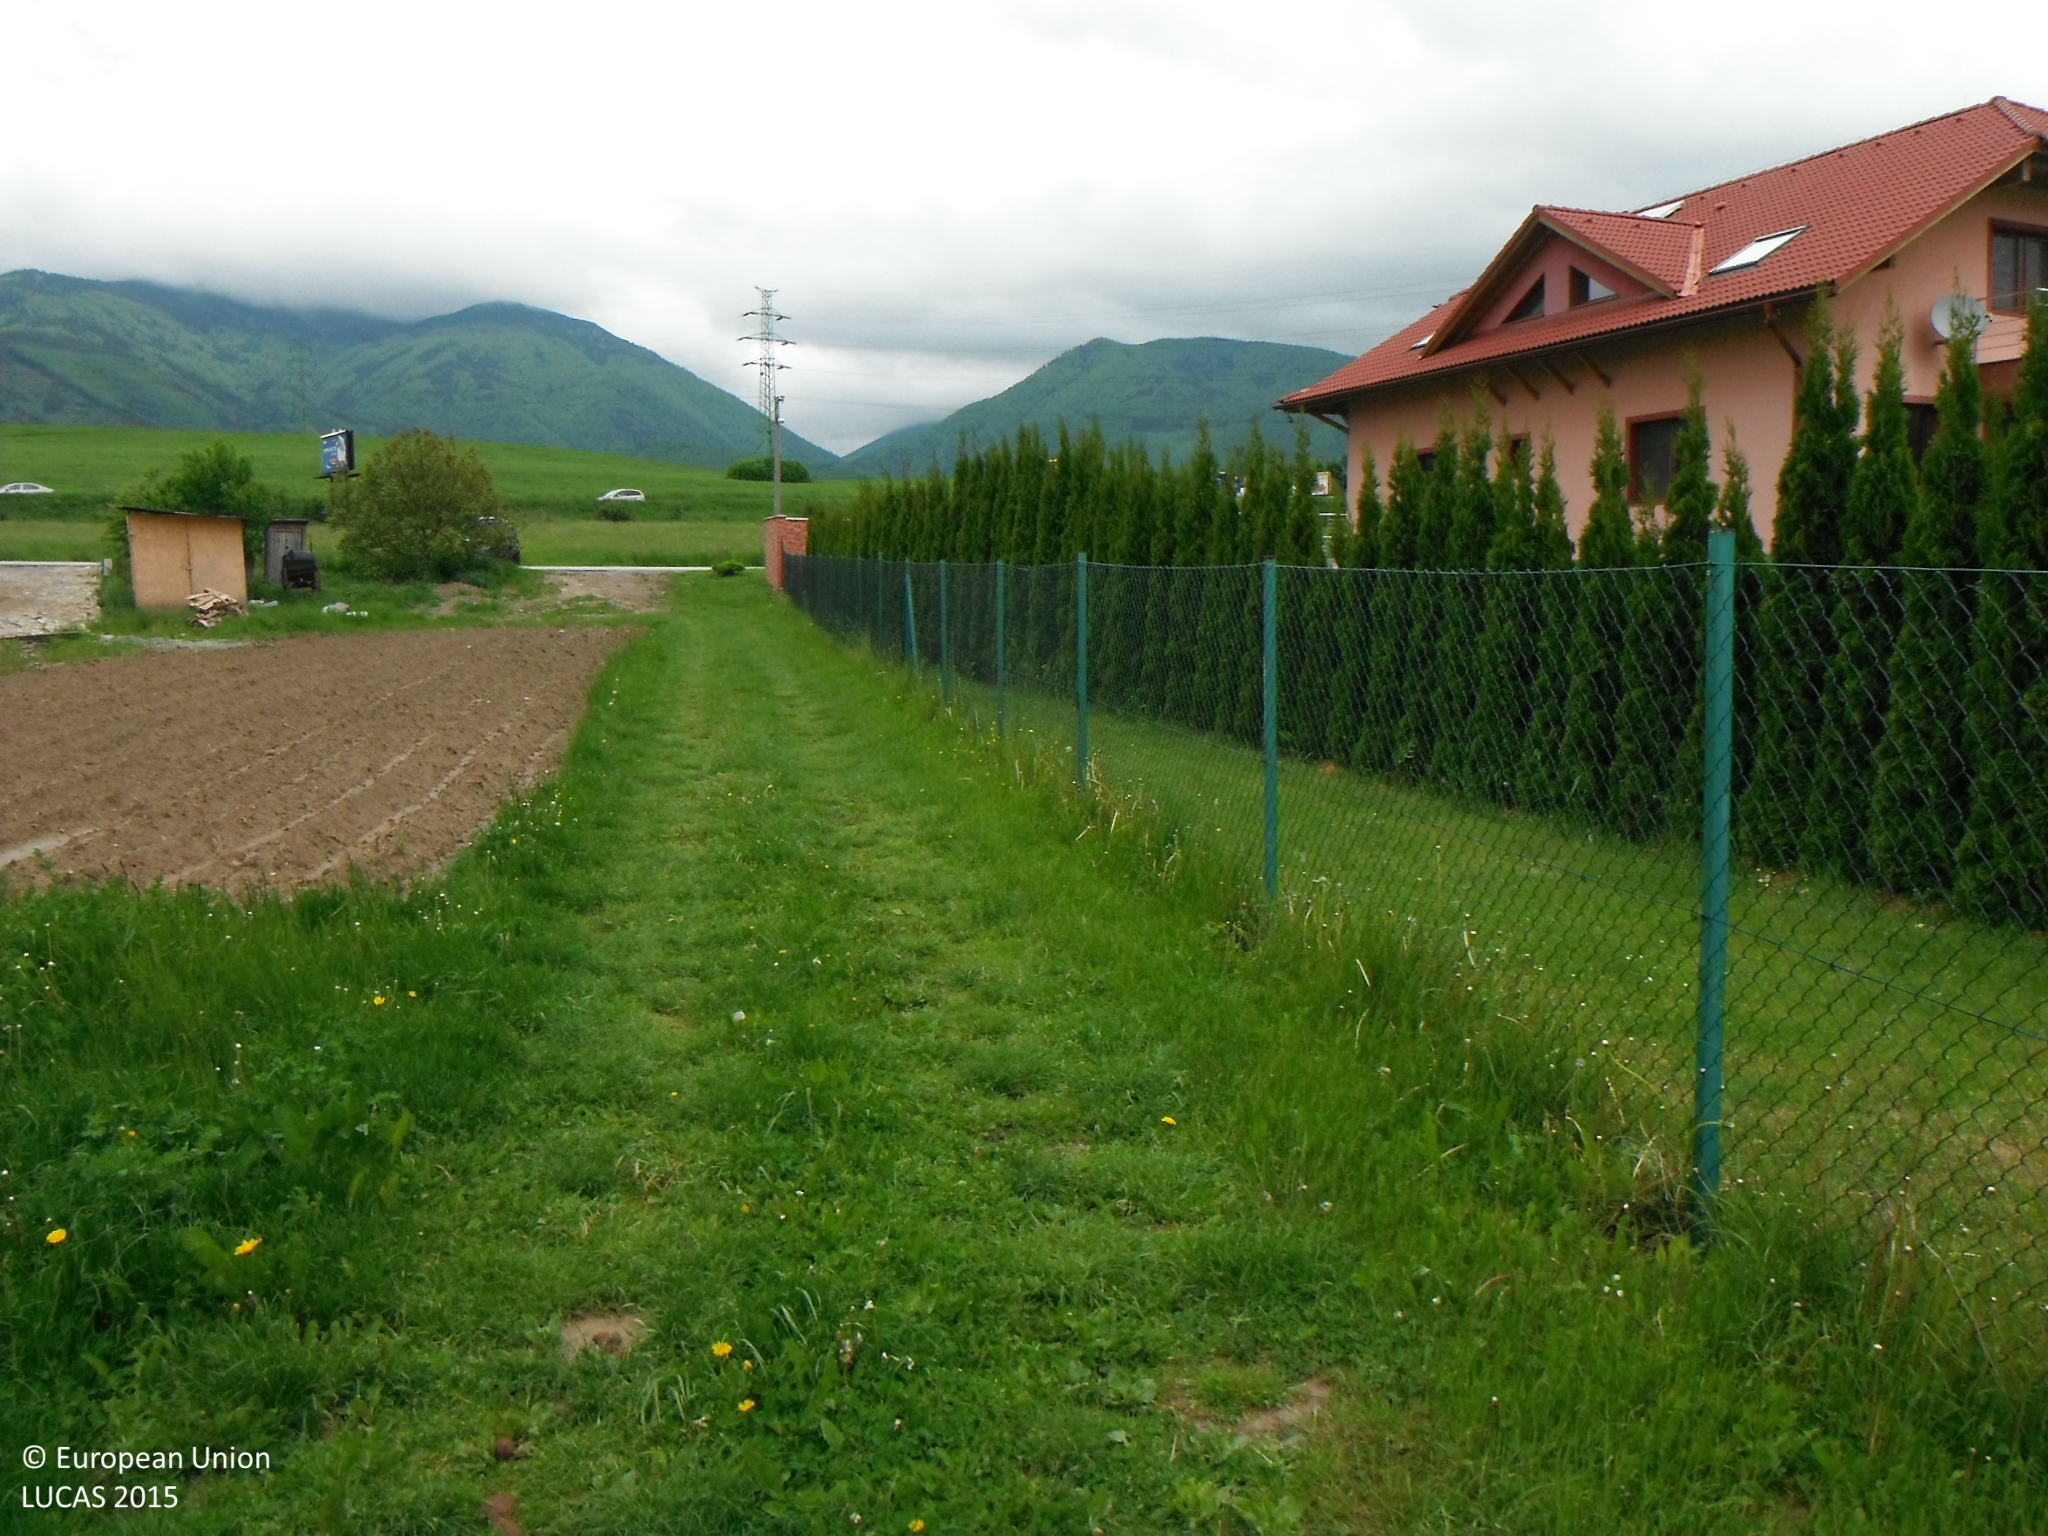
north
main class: Grassland
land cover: Grassland without tree/shrub cover
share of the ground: > 75 %
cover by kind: herbaceous plants 100 %
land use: Residential
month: May
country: SK
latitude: 49.1334
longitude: 19.0819
